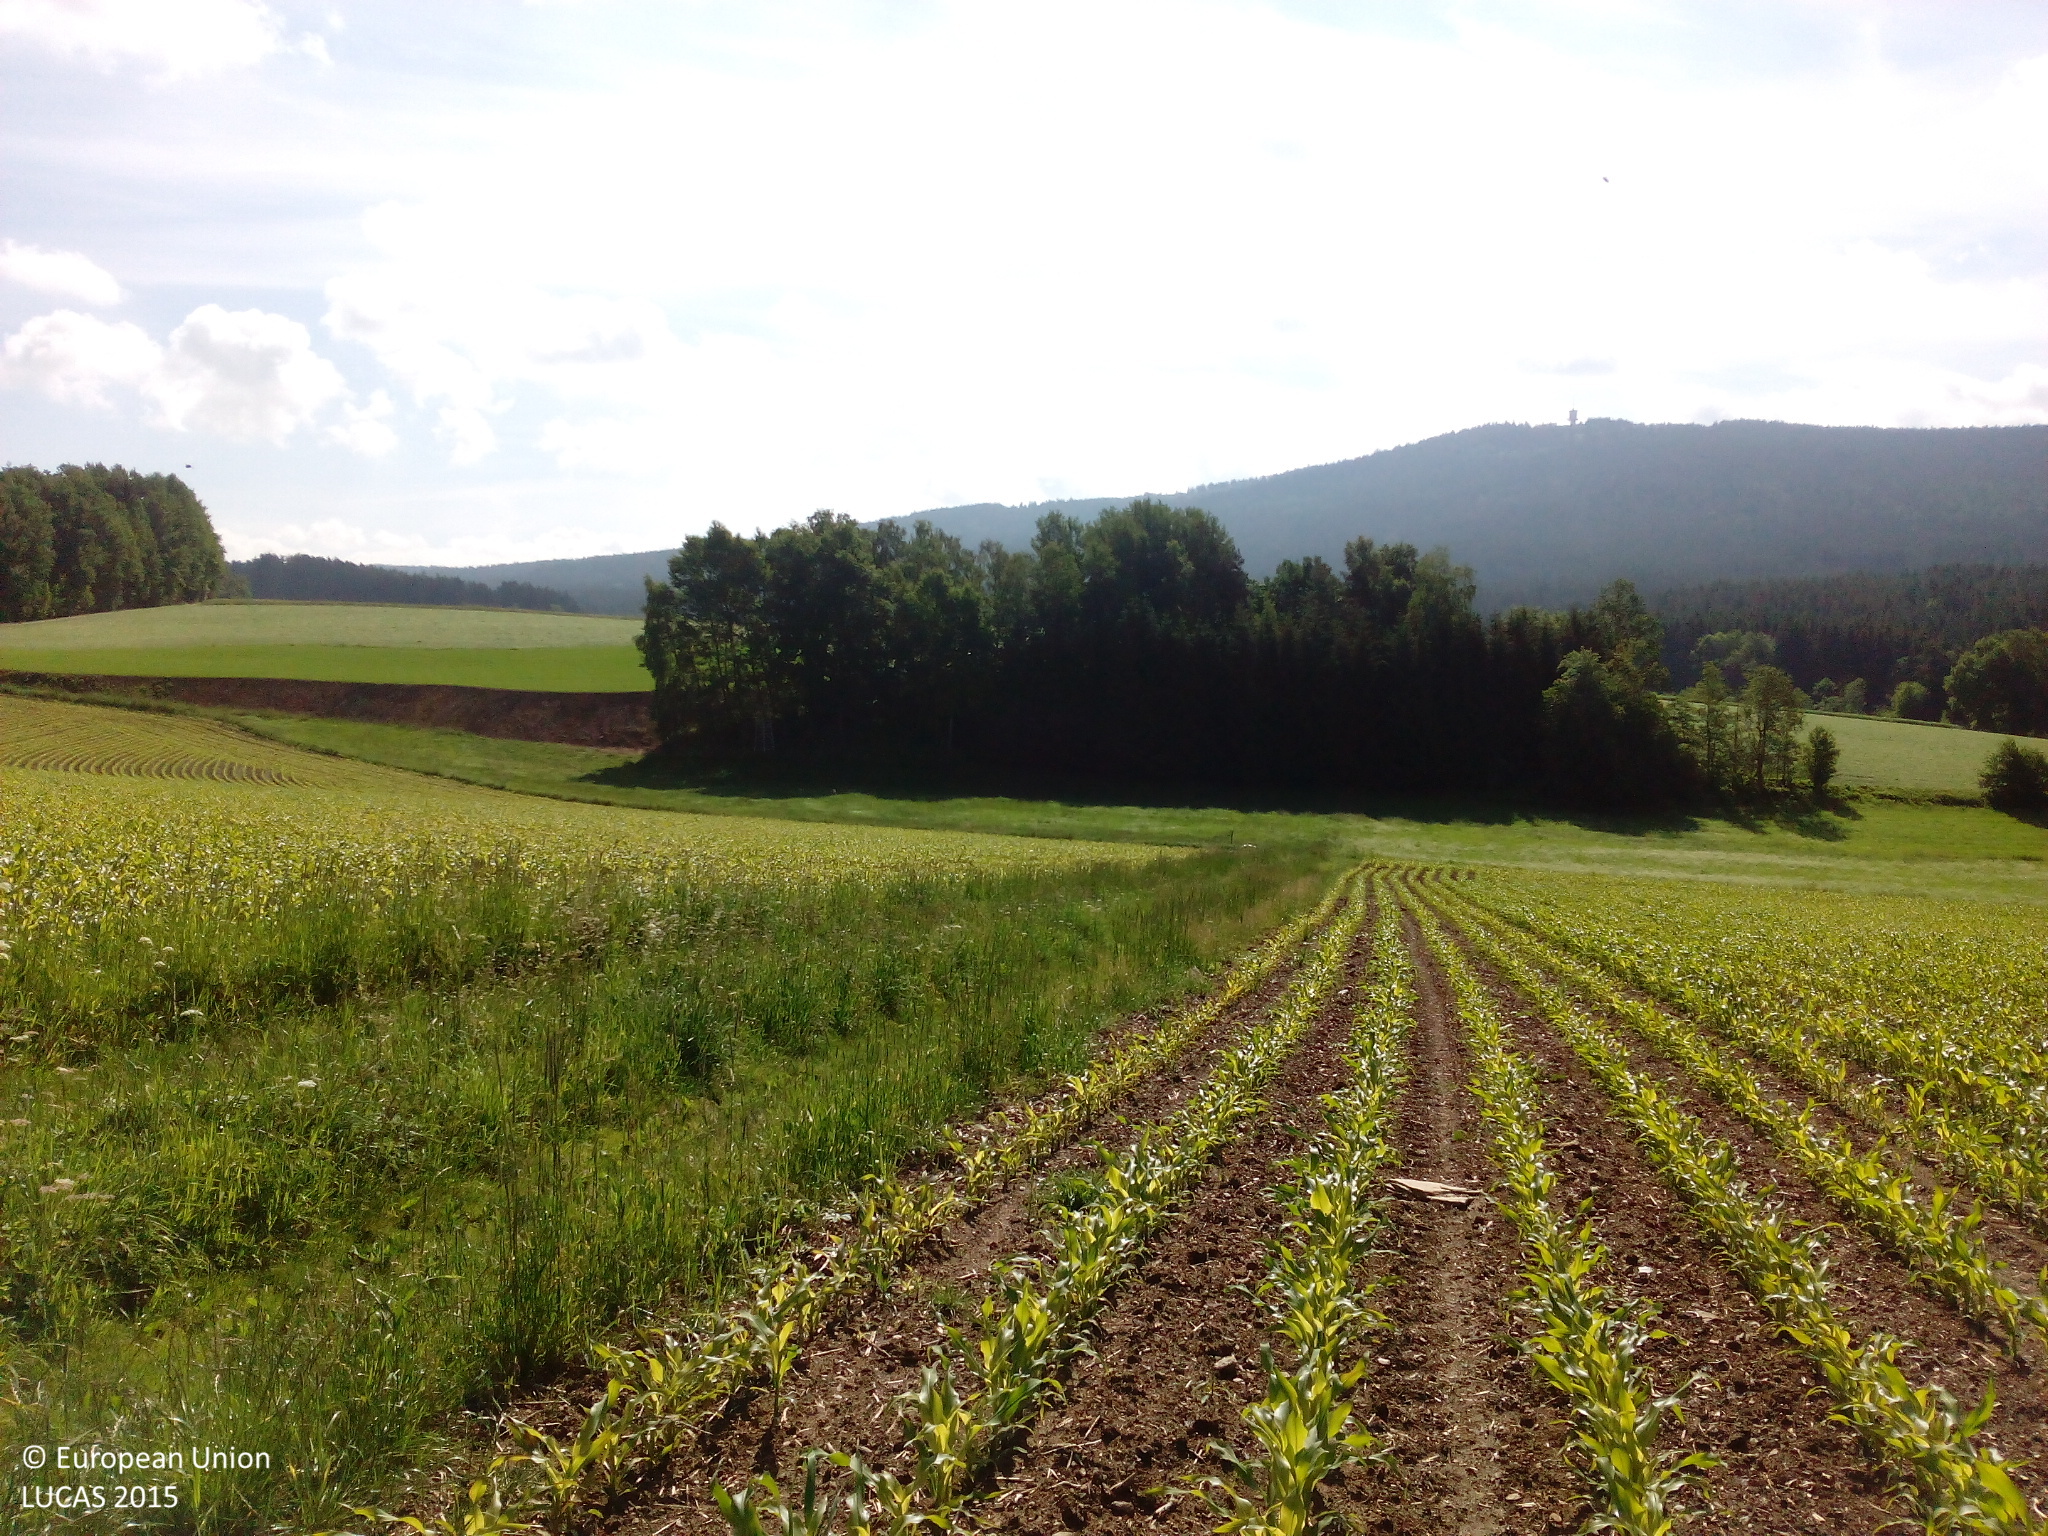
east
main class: Cropland
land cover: Maize
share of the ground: 25 - 50 %
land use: Agriculture (excluding fallow land and kitchen gardens)
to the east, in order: Maize; Grass margins; Tracks; Grass margins; Maize; Grassland without tree/shrub cover; Broadleaved woodland; Grassland without tree/shrub cover
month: June
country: DE
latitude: 49.9776
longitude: 12.4679
